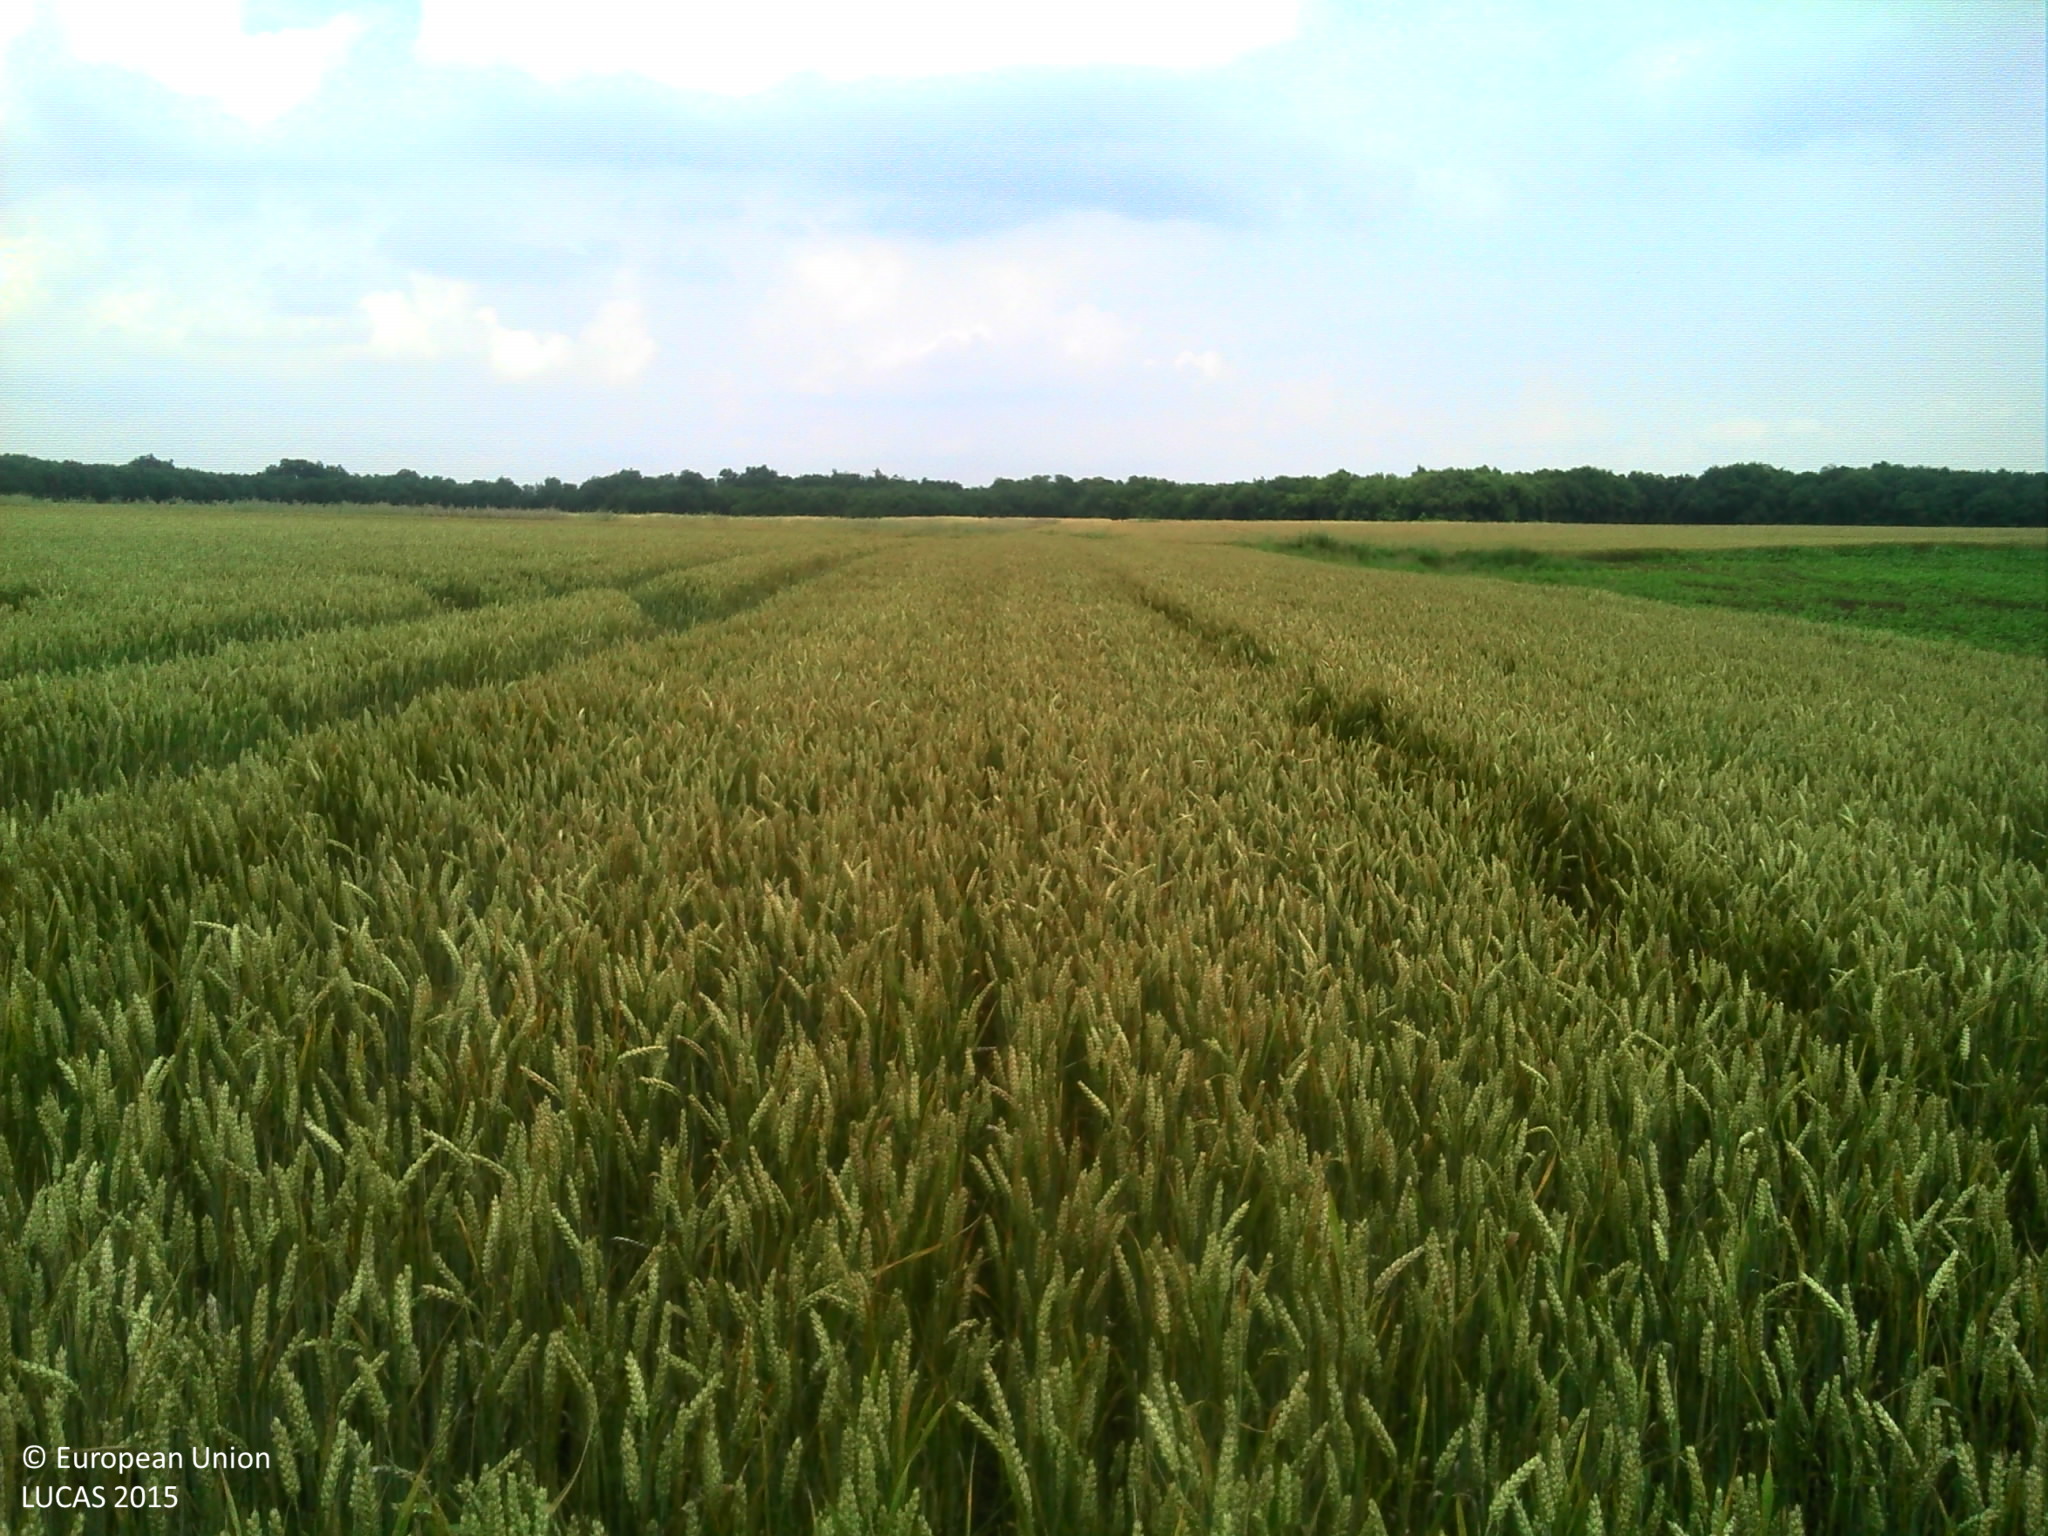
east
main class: Cropland
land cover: Common wheat
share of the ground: > 75 %
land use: Agriculture (excluding fallow land and kitchen gardens)
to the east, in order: Common wheat; Grass margins; Ditches and canals; Grass margins; Durum wheat
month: June
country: FR
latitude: 45.9051
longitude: -0.6859
